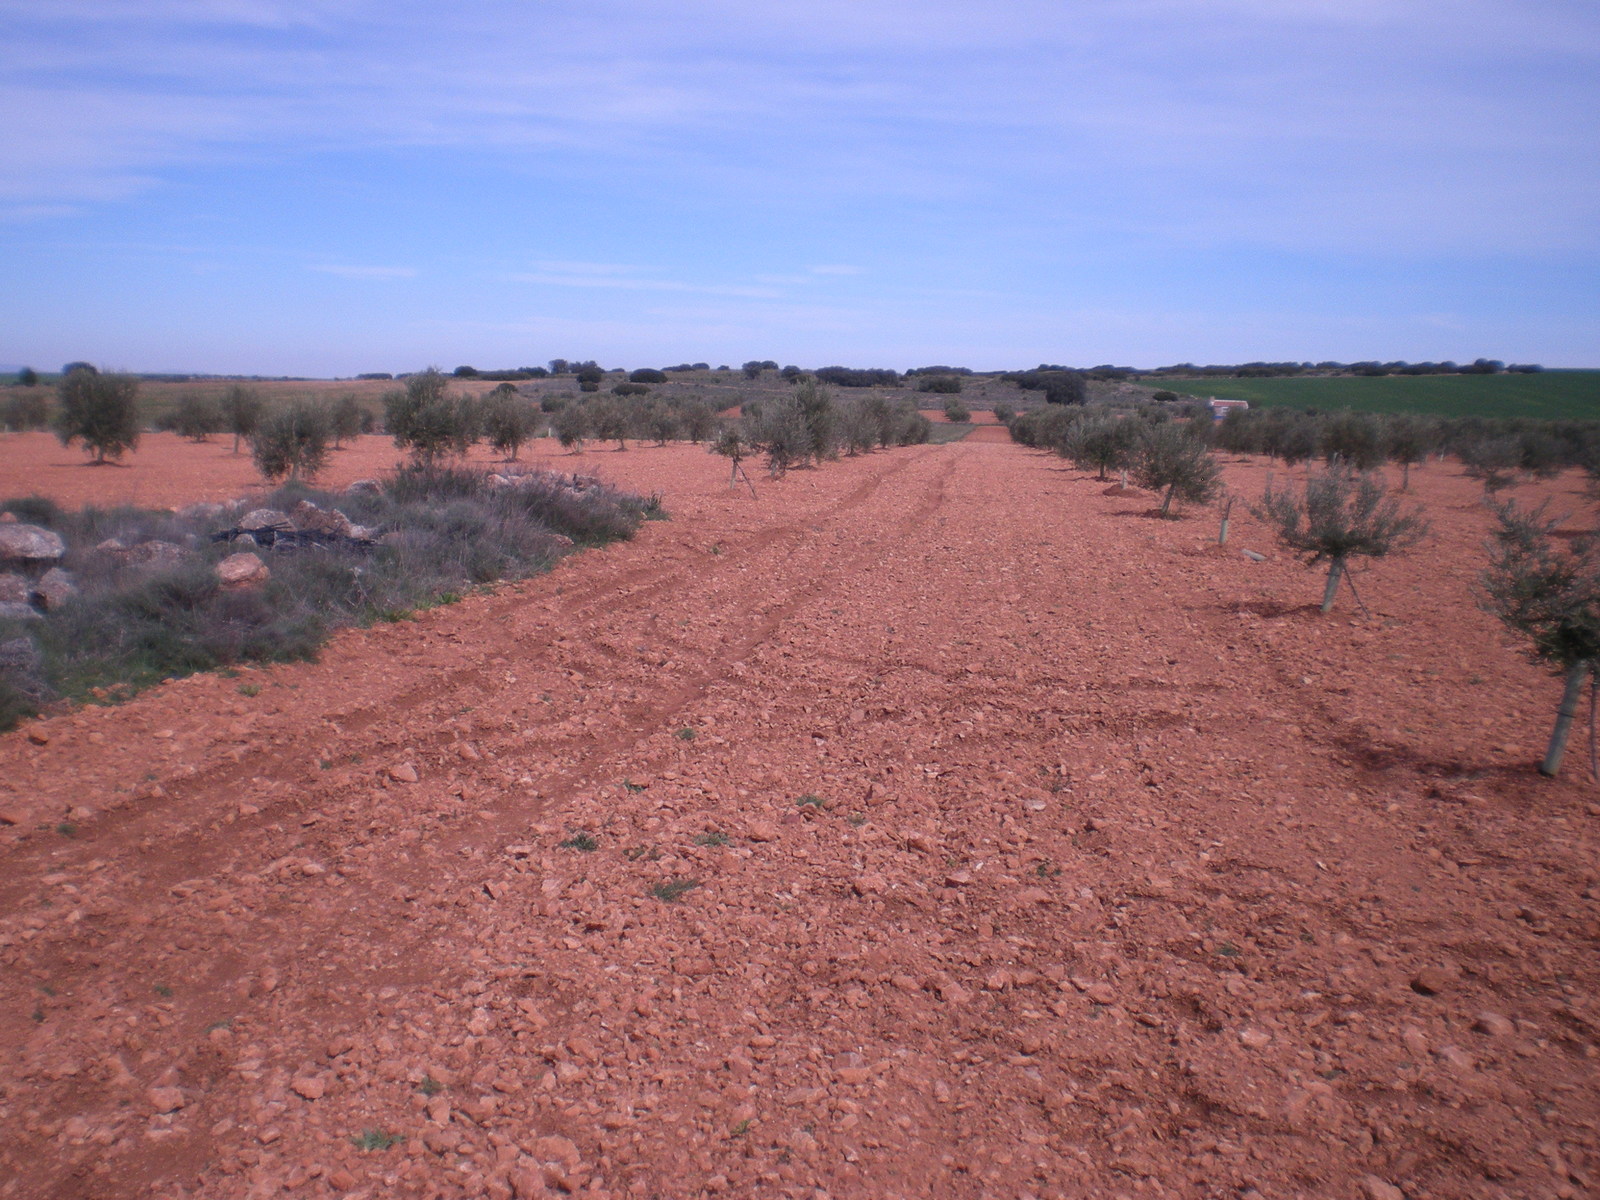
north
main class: Cropland
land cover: Olive groves
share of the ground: < 10 %
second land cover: Other bare soil
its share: > 75 %
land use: Agriculture (excluding fallow land and kitchen gardens)
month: March
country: ES
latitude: 39.0065
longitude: -3.1883
